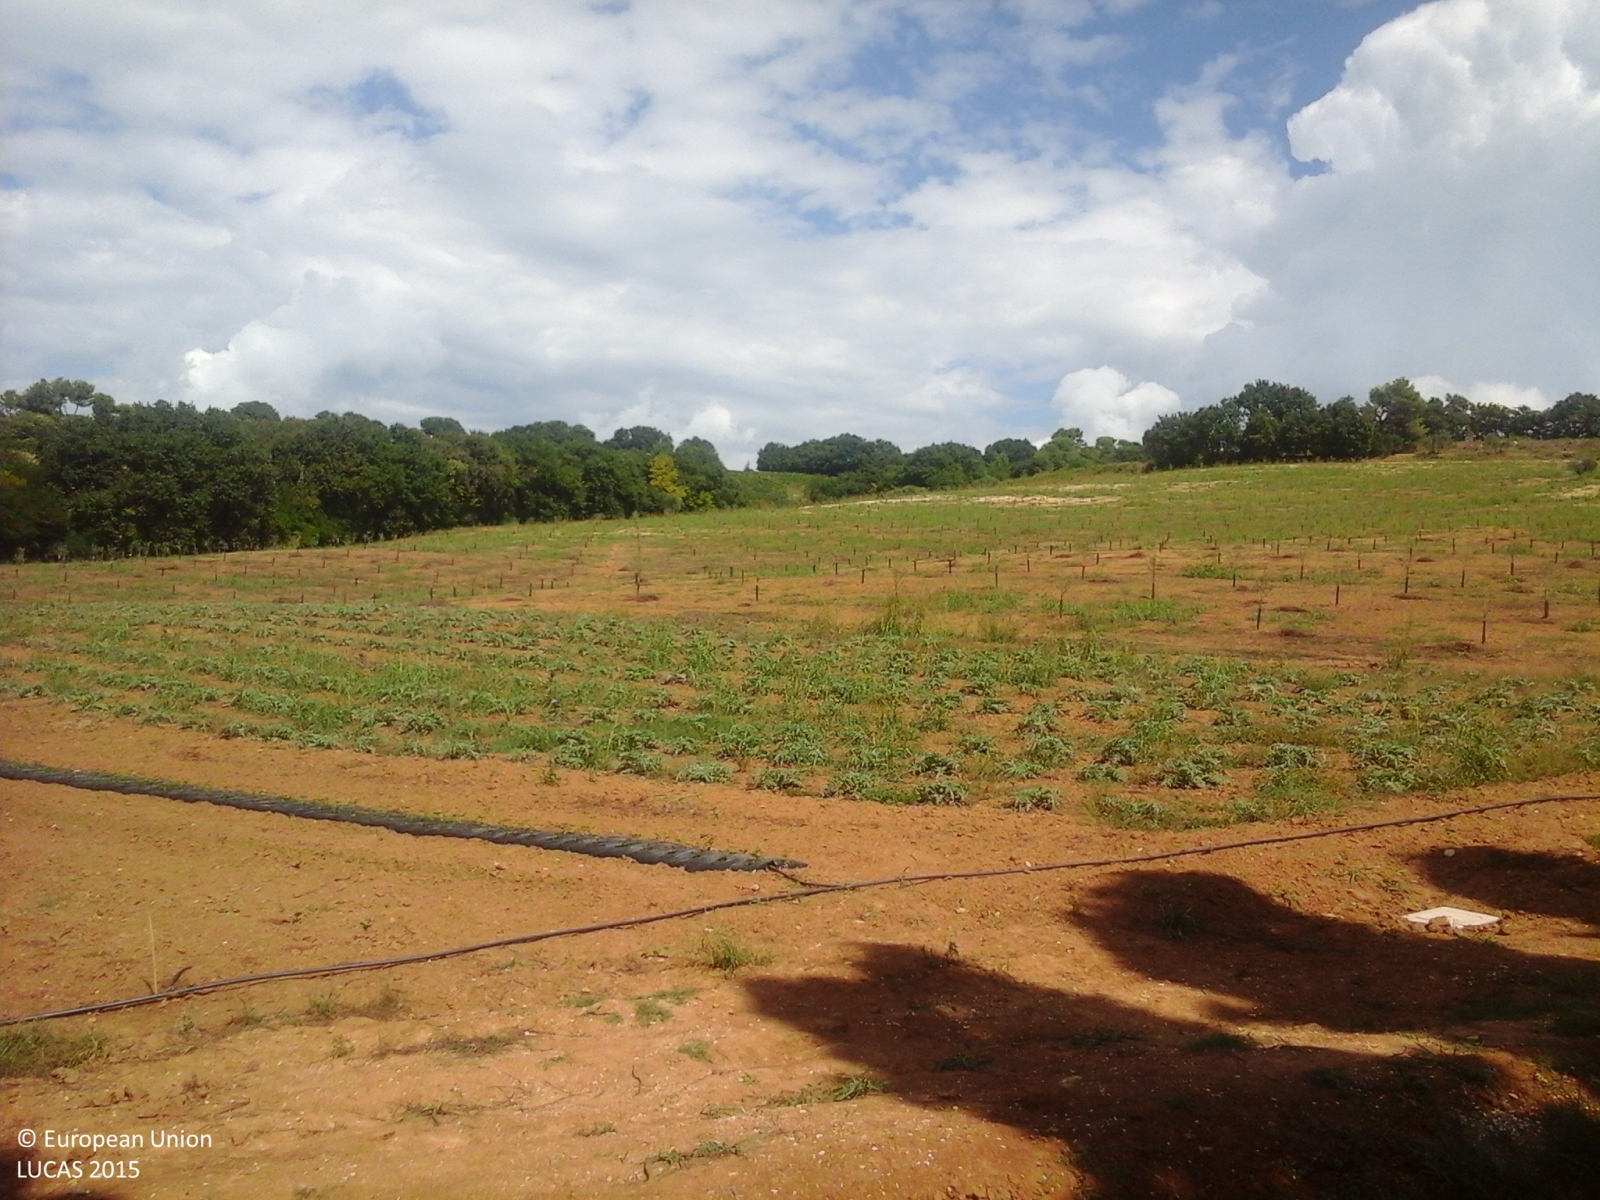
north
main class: Woodland
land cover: Broadleaved woodland
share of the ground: > 75 %
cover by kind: broadleaved forest trees 100 %
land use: Residential
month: September
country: IT
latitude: 43.9138
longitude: 12.8700
